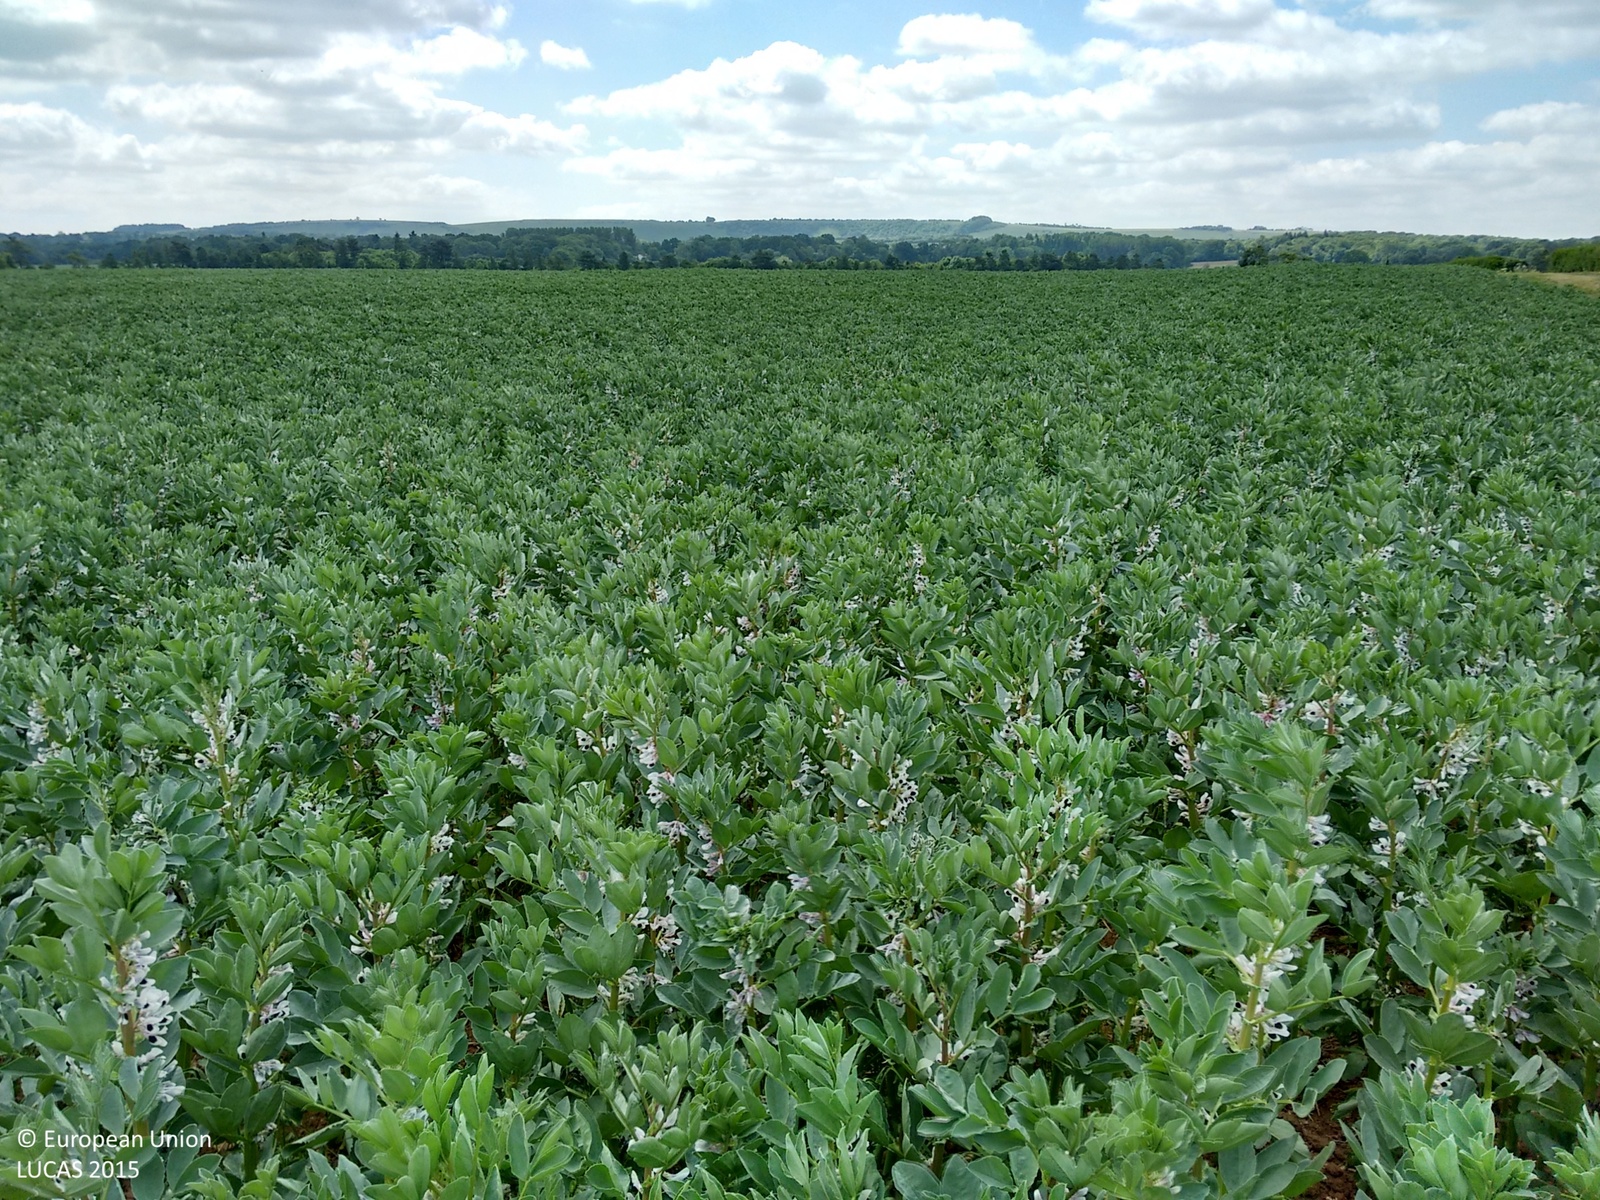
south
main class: Cropland
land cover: Dry pulses
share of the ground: > 75 %
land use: Agriculture (excluding fallow land and kitchen gardens)
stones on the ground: 10 - 25 %
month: June
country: GB
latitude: 51.3979
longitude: -1.5068
